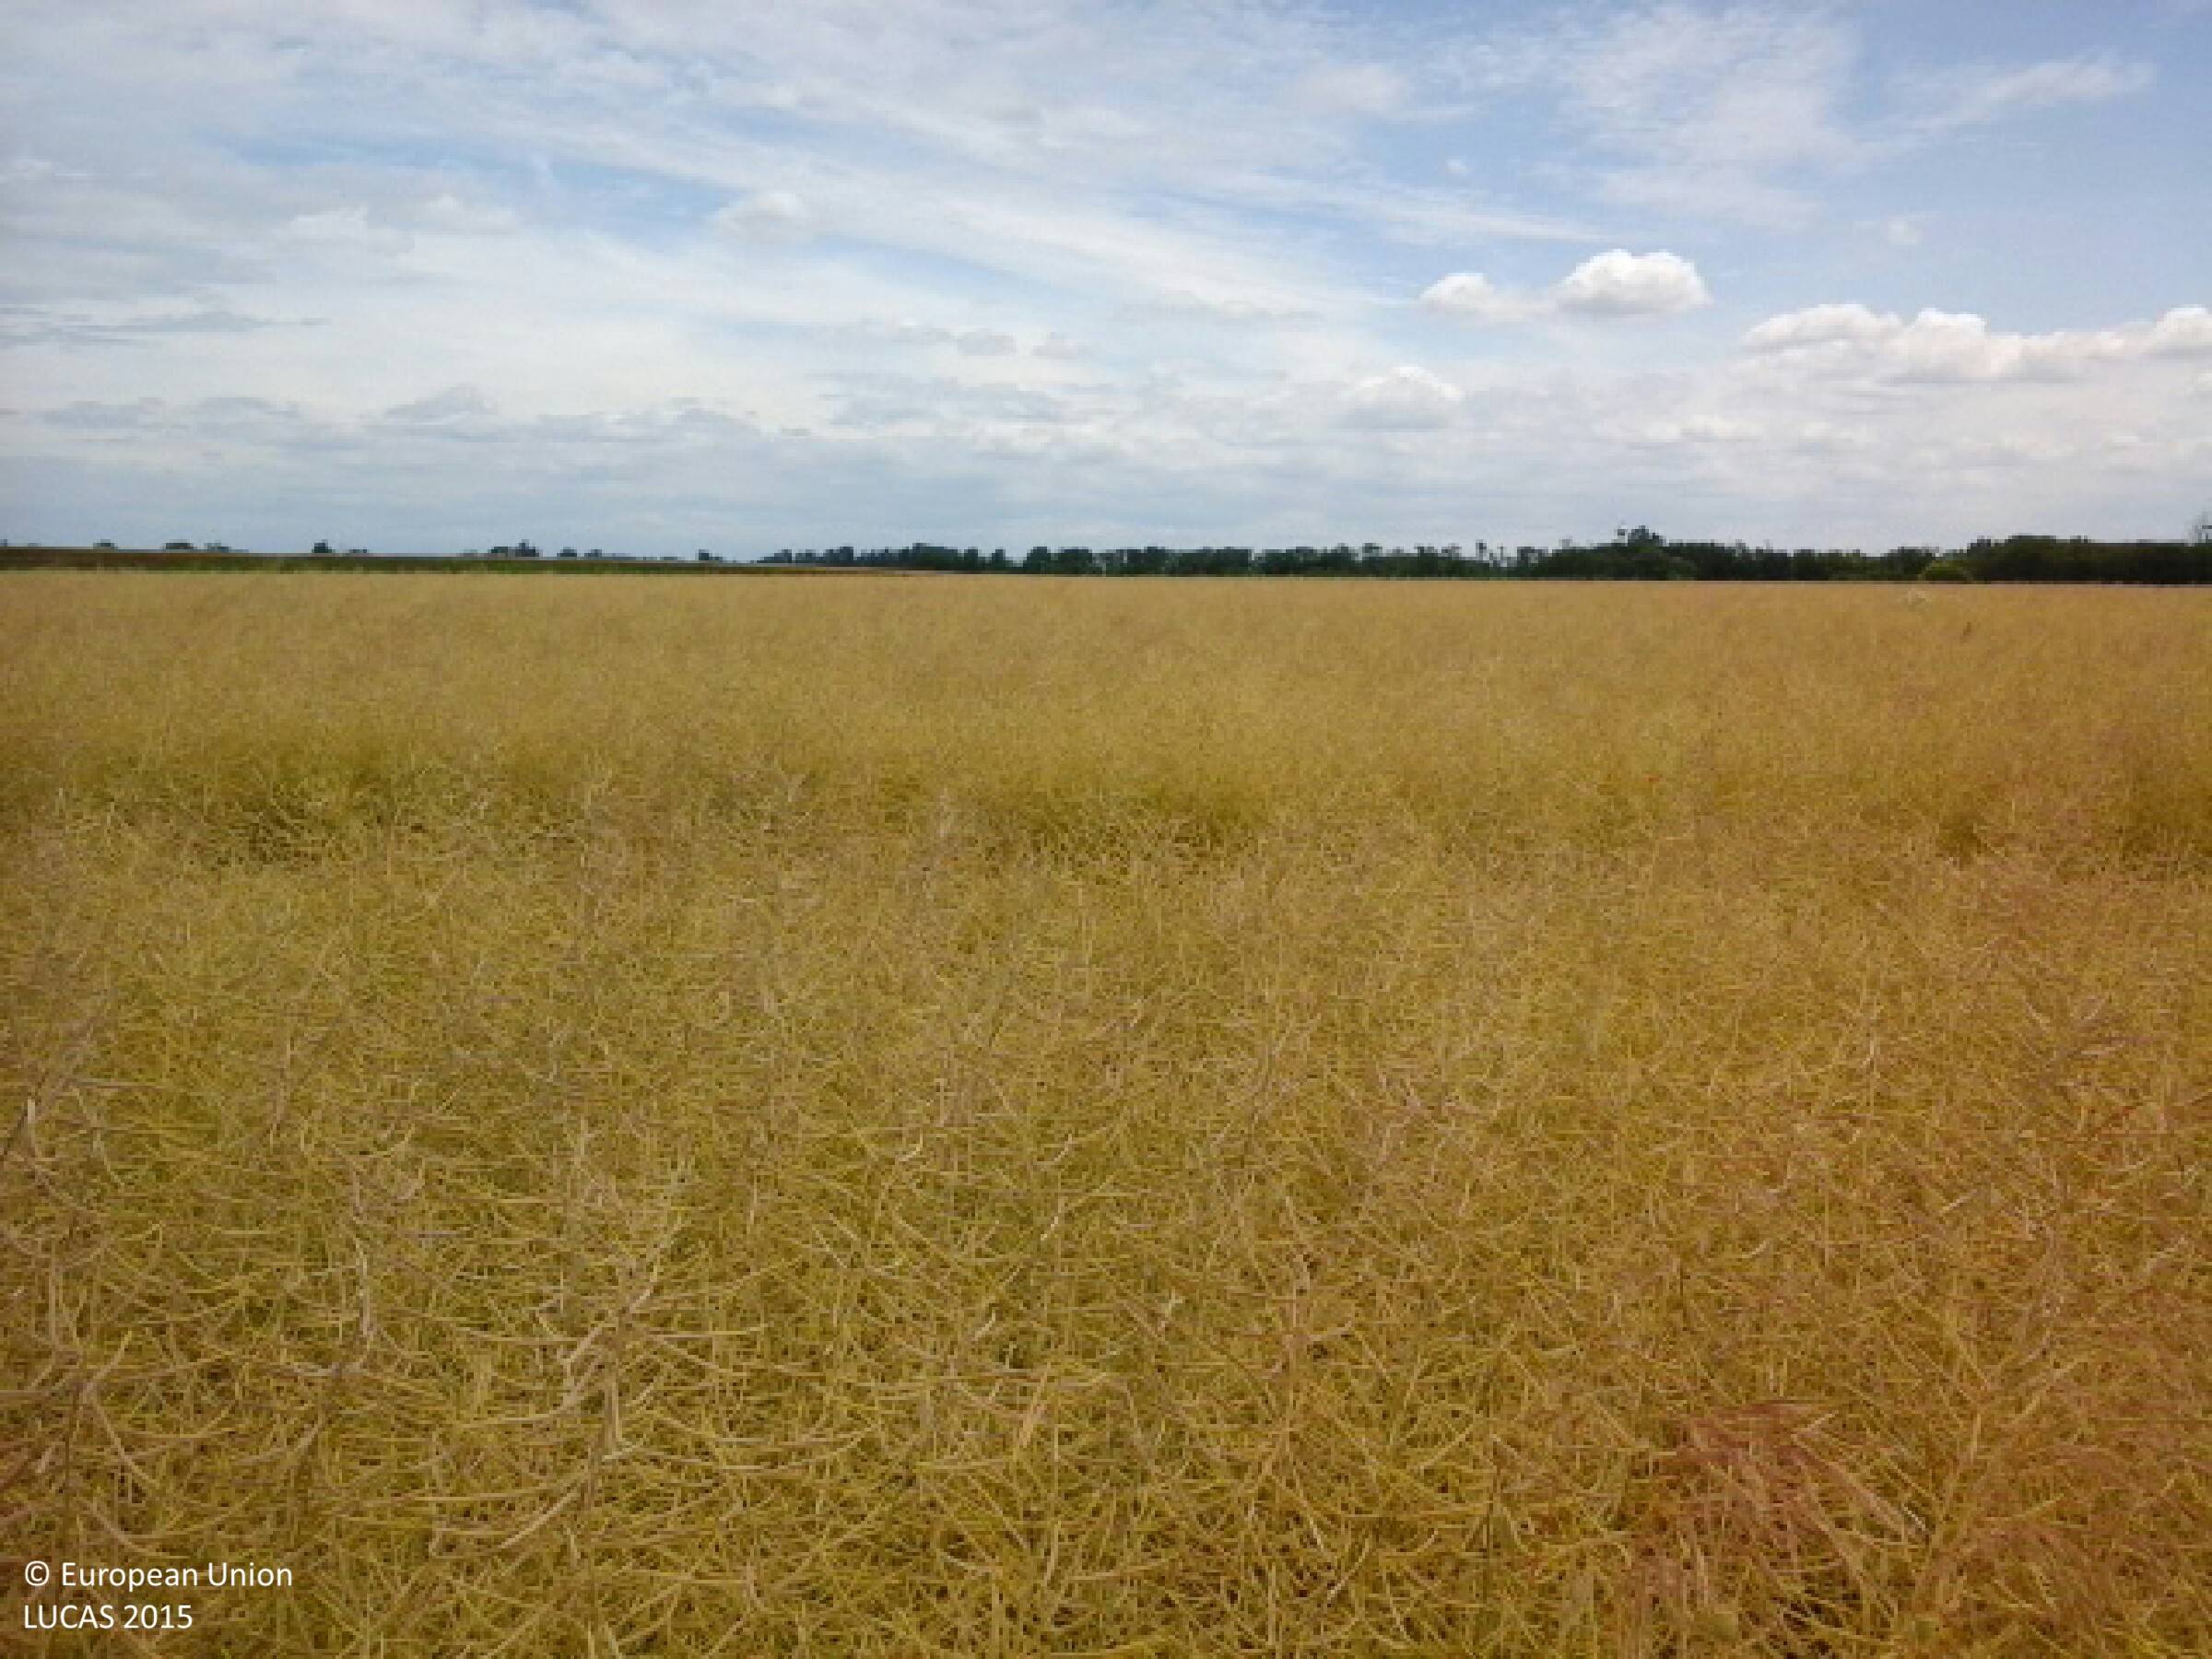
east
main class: Cropland
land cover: Rape and turnip rape
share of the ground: > 75 %
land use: Agriculture (excluding fallow land and kitchen gardens)
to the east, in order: Rape and turnip rape; Maize
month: June
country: HU
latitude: 47.9801
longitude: 21.5270
